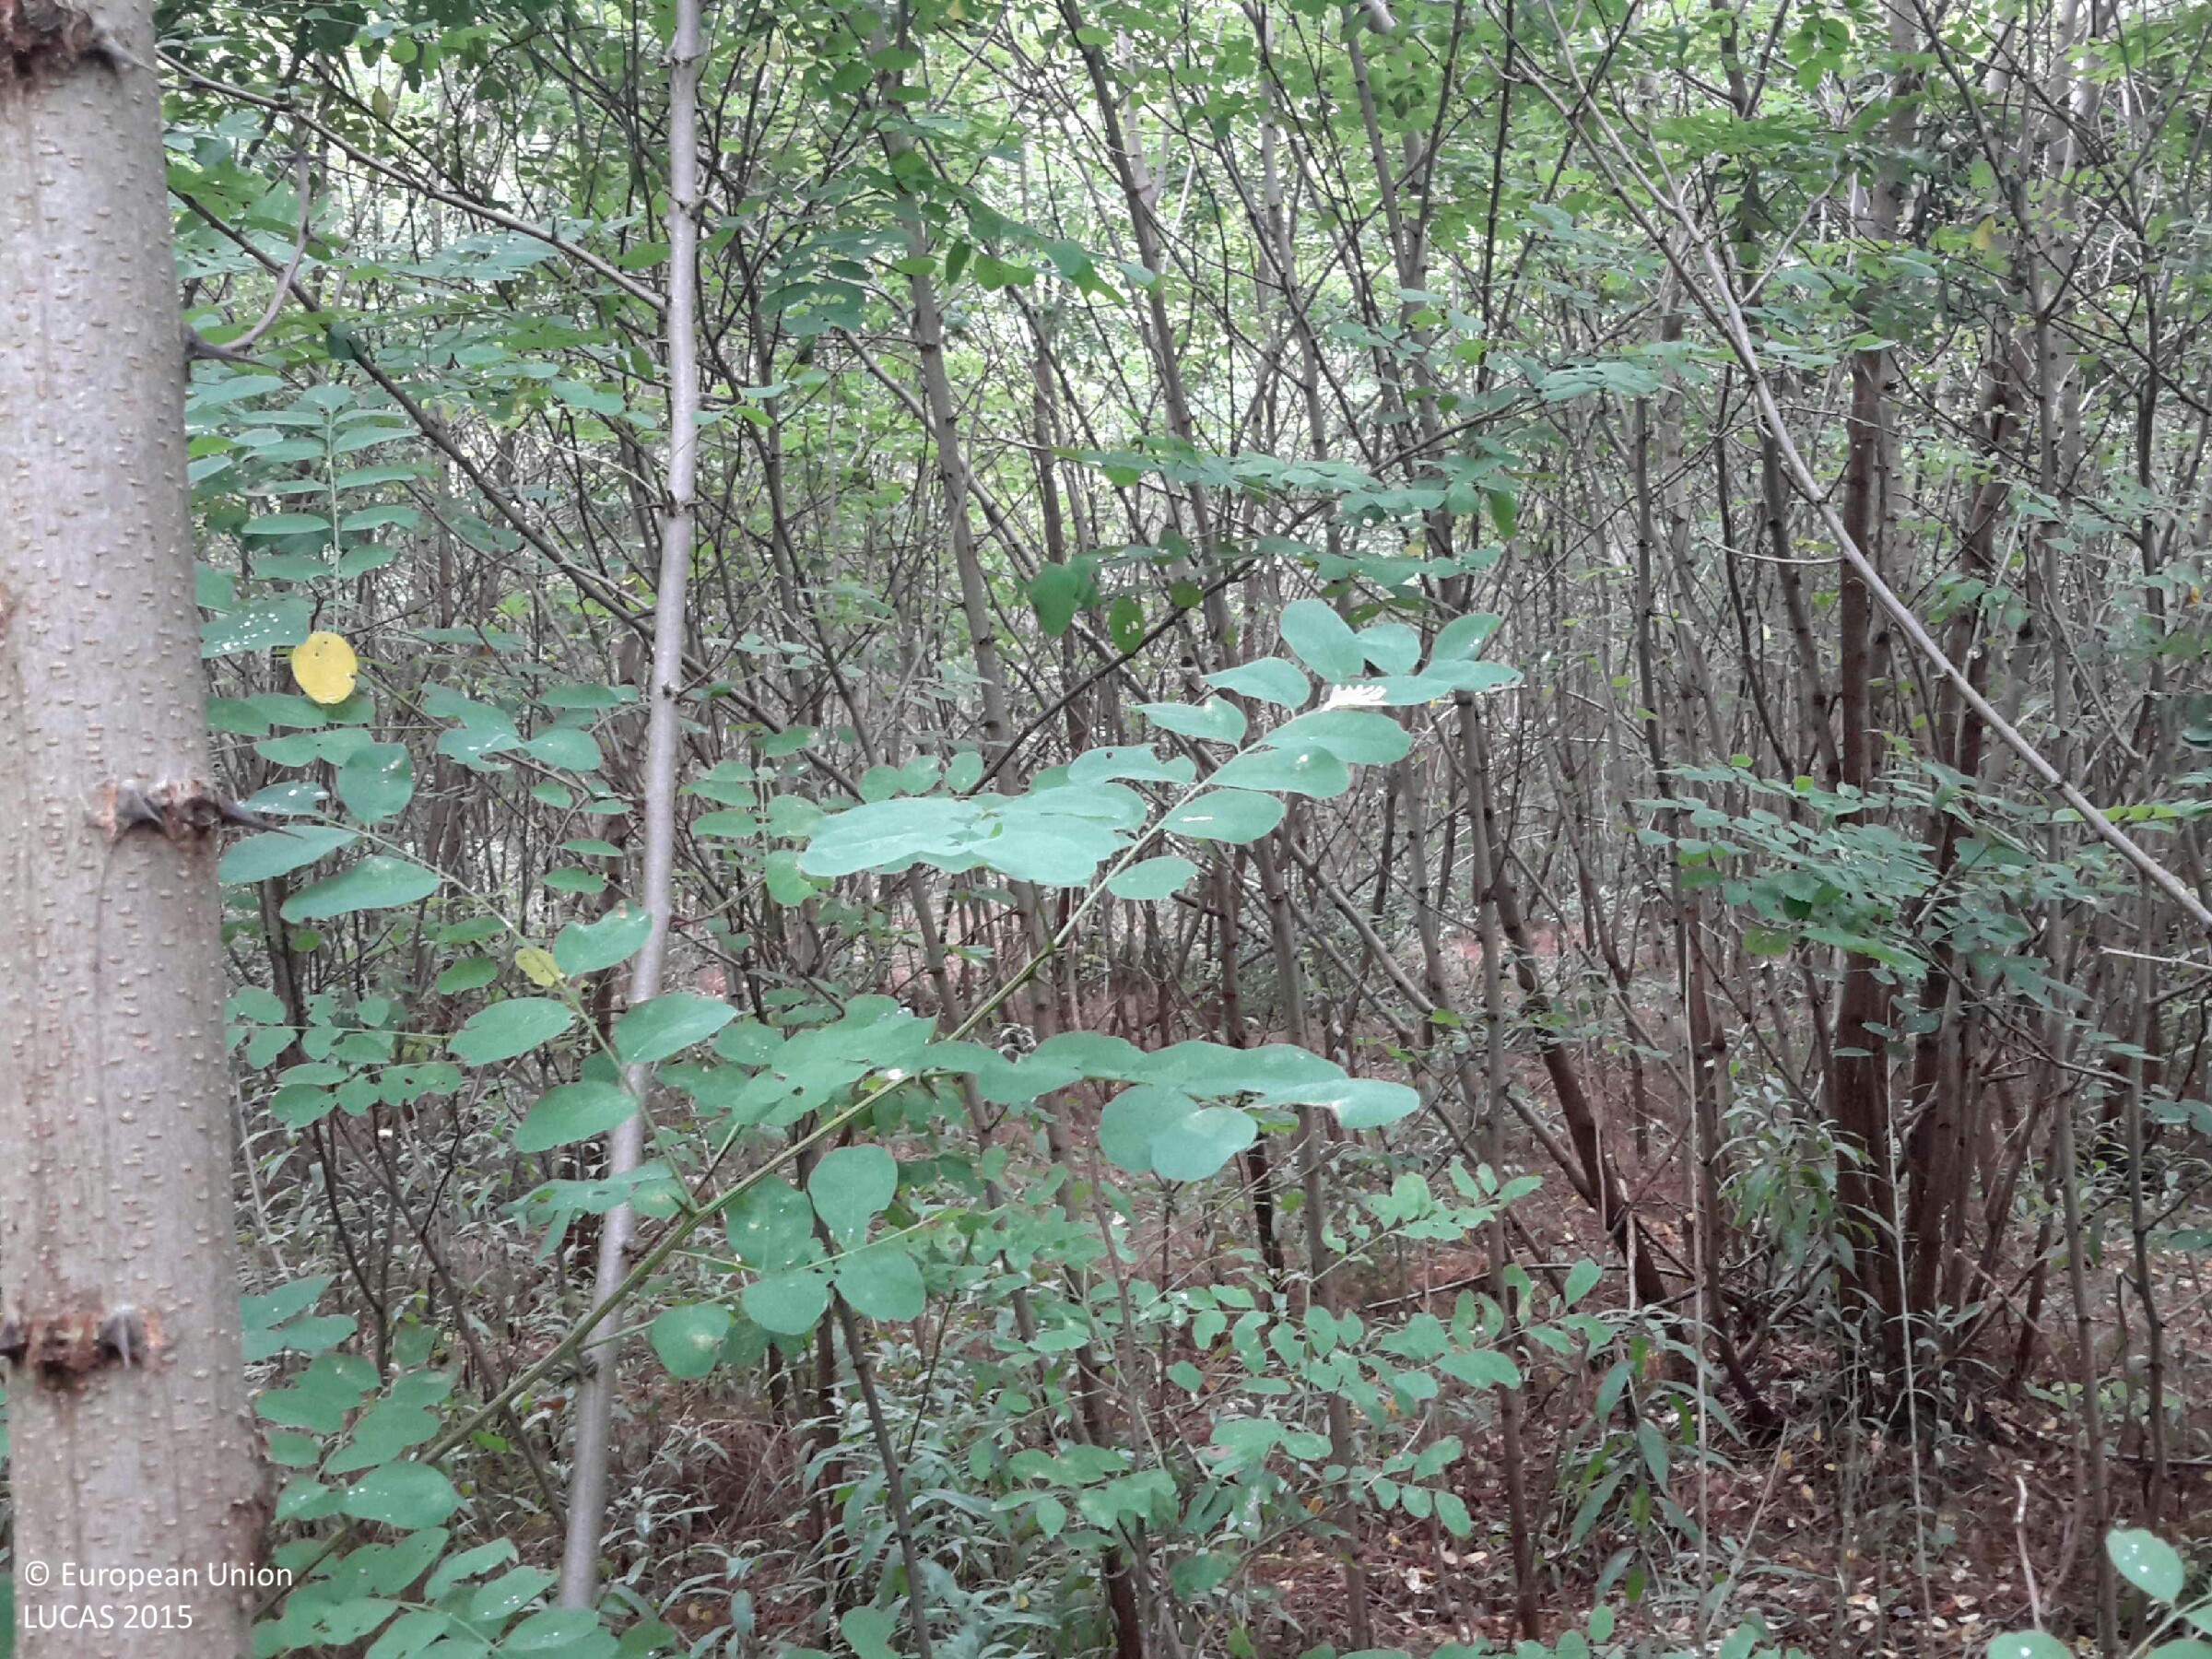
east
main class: Woodland
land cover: Broadleaved woodland
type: exotic forest
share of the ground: > 75 %
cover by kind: broadleaved forest trees 60 %, shrubs 35 %, herbaceous plants 5 %
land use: Forestry
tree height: > 5 m
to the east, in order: Broadleaved woodland; Tracks; Pine dominated coniferous woodland
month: July
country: HU
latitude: 47.5529
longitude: 17.4896
